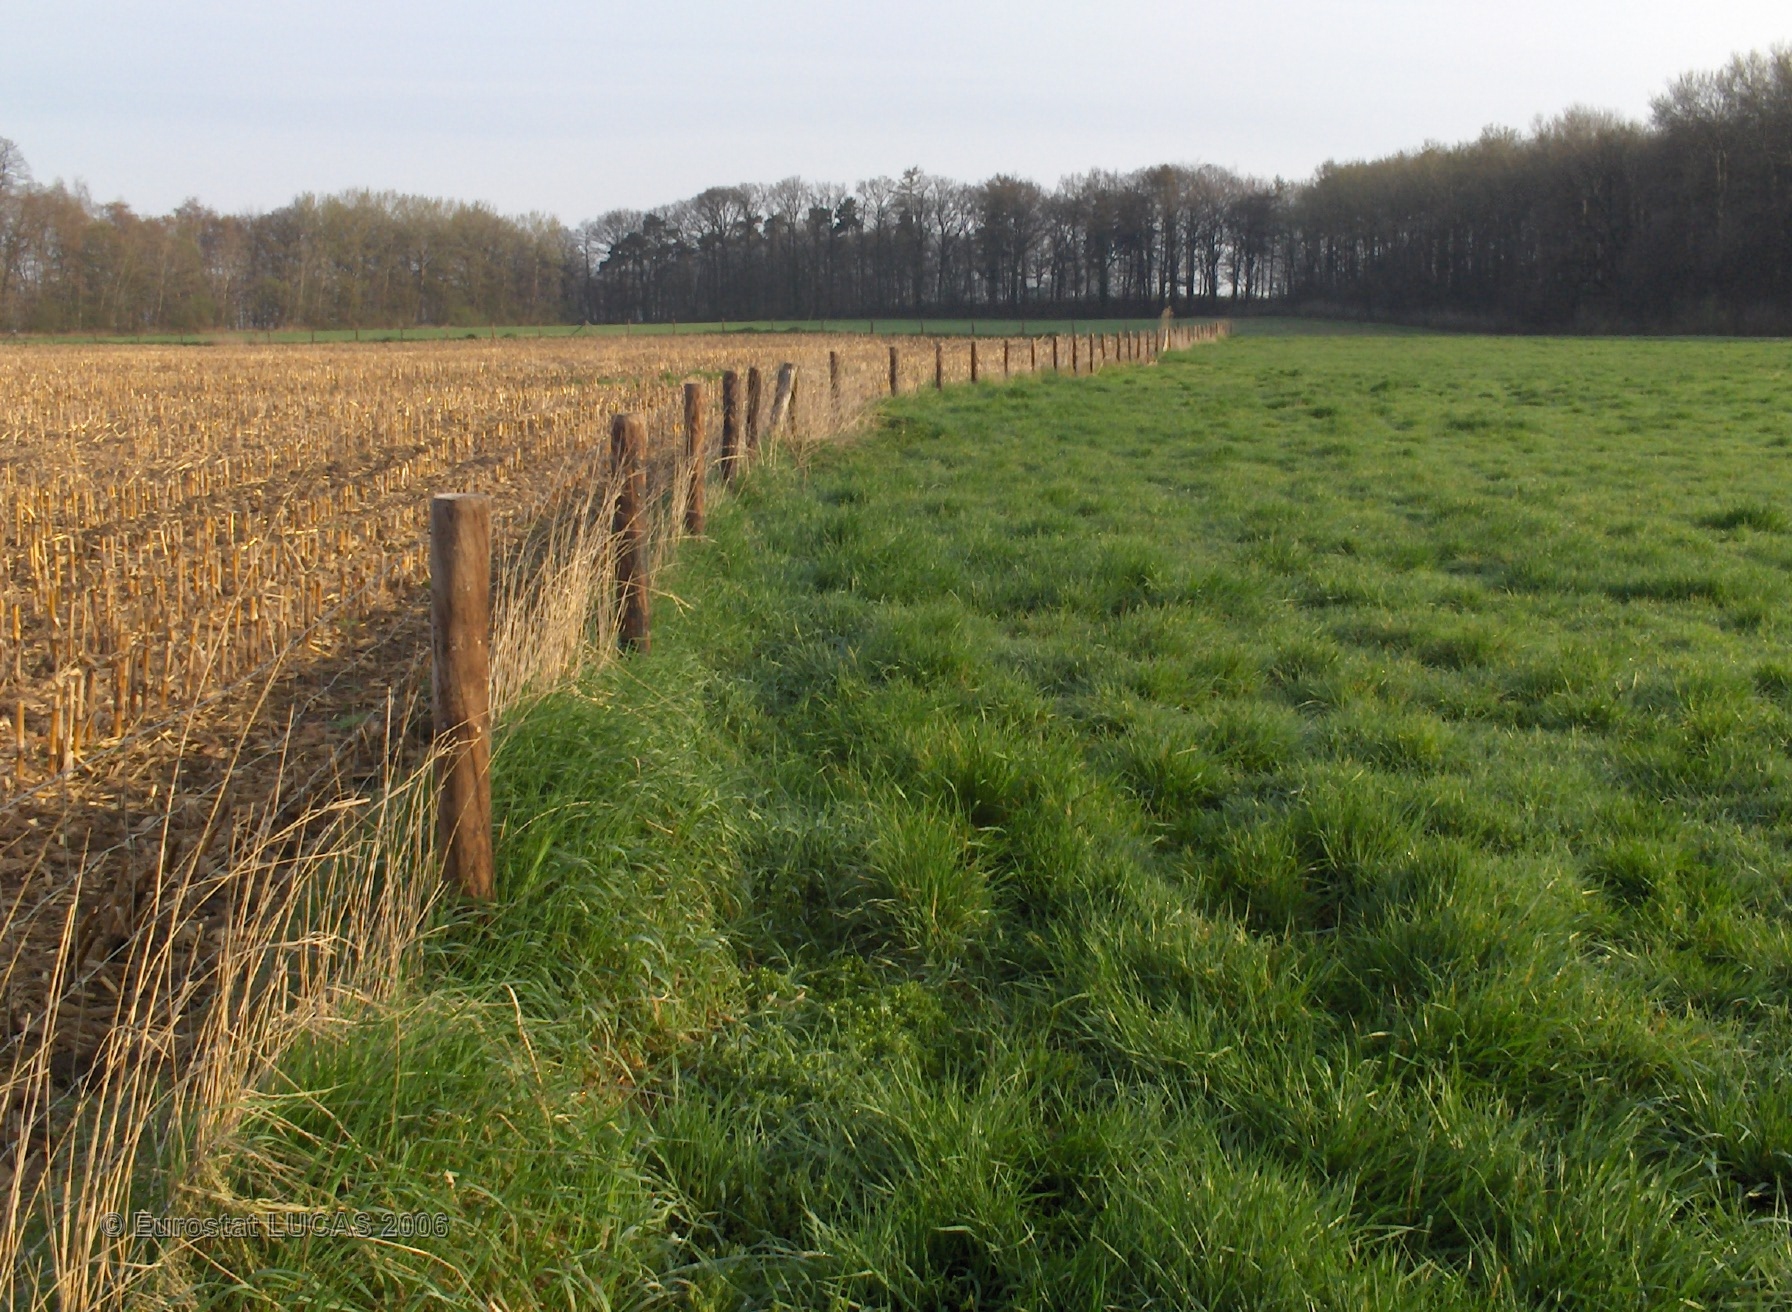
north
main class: Grassland
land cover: Grassland without tree/shrub cover
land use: Agriculture (excluding fallow land and kitchen gardens)
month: April
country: BE
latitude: 50.8582
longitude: 5.2100
